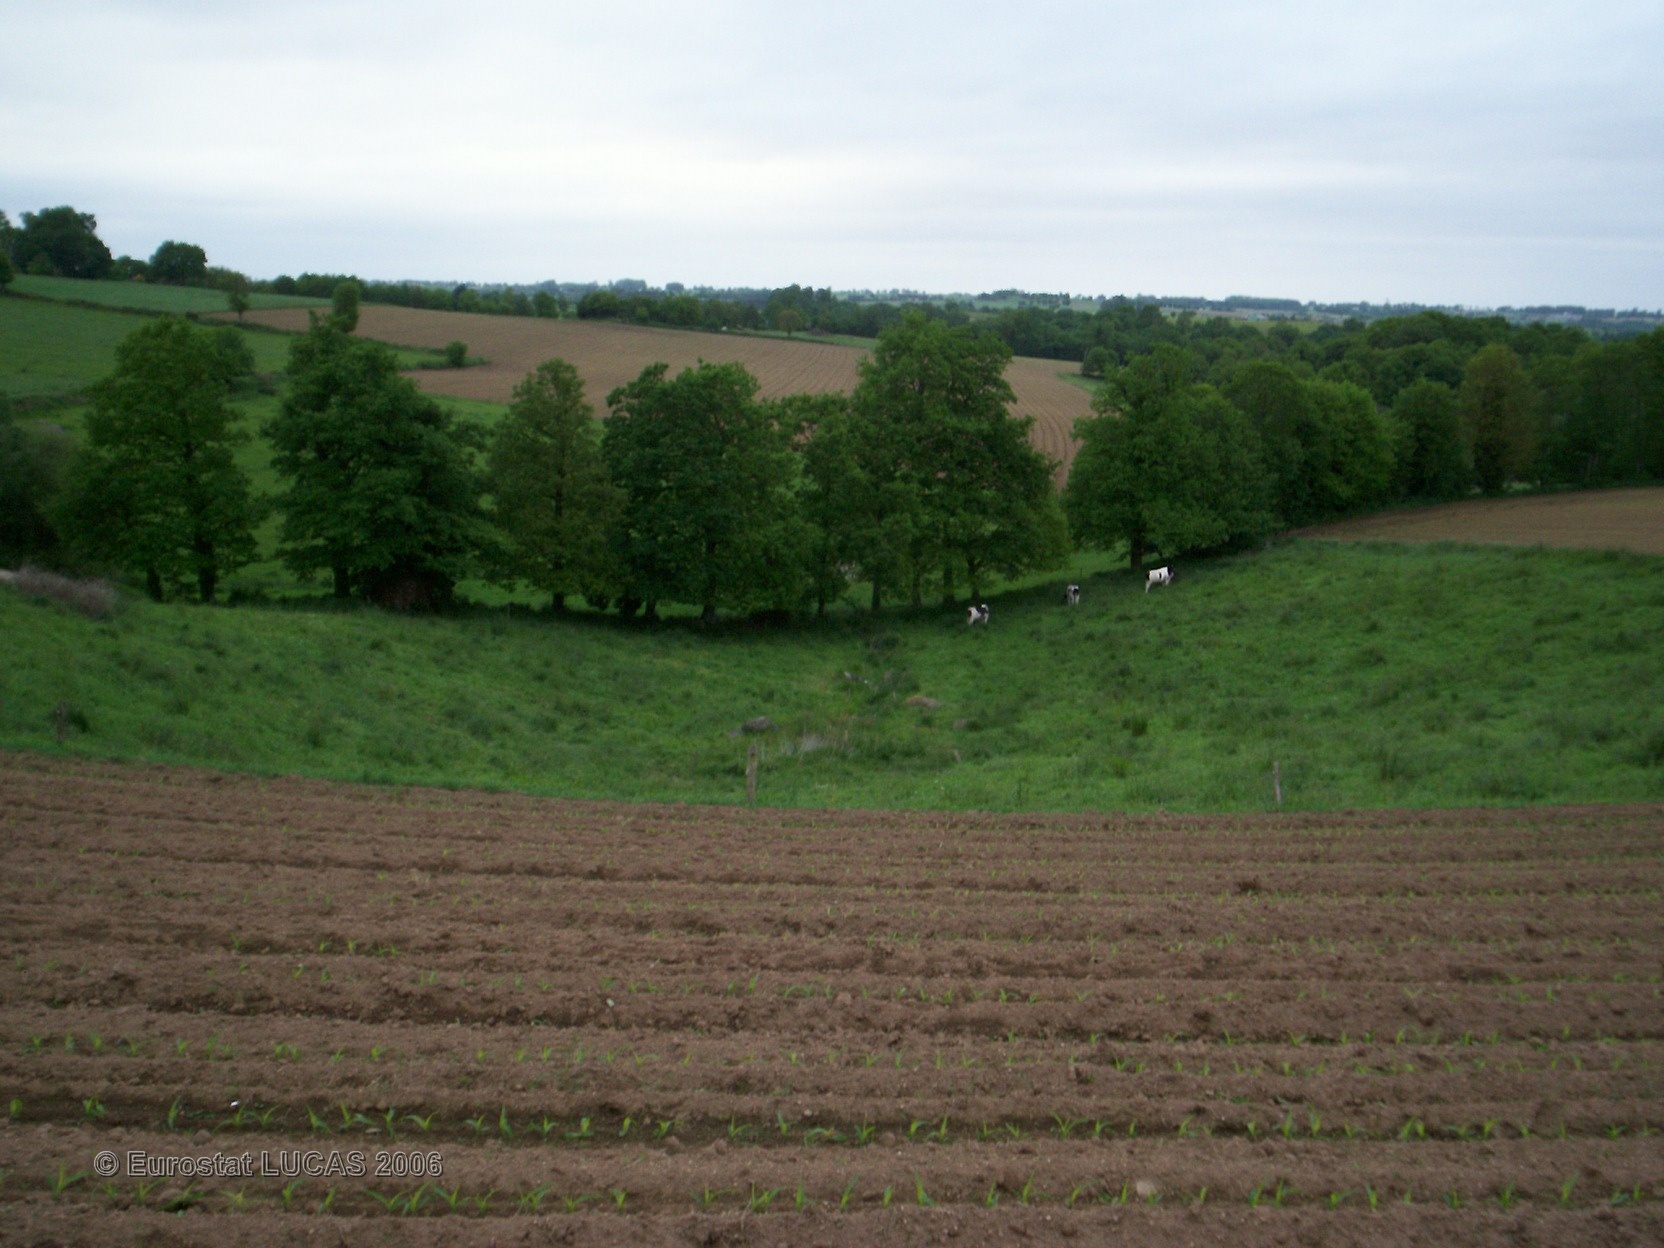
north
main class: Cropland
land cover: Maize
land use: Agriculture (excluding fallow land and kitchen gardens)
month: May
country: FR
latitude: 48.3506
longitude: -2.4616
